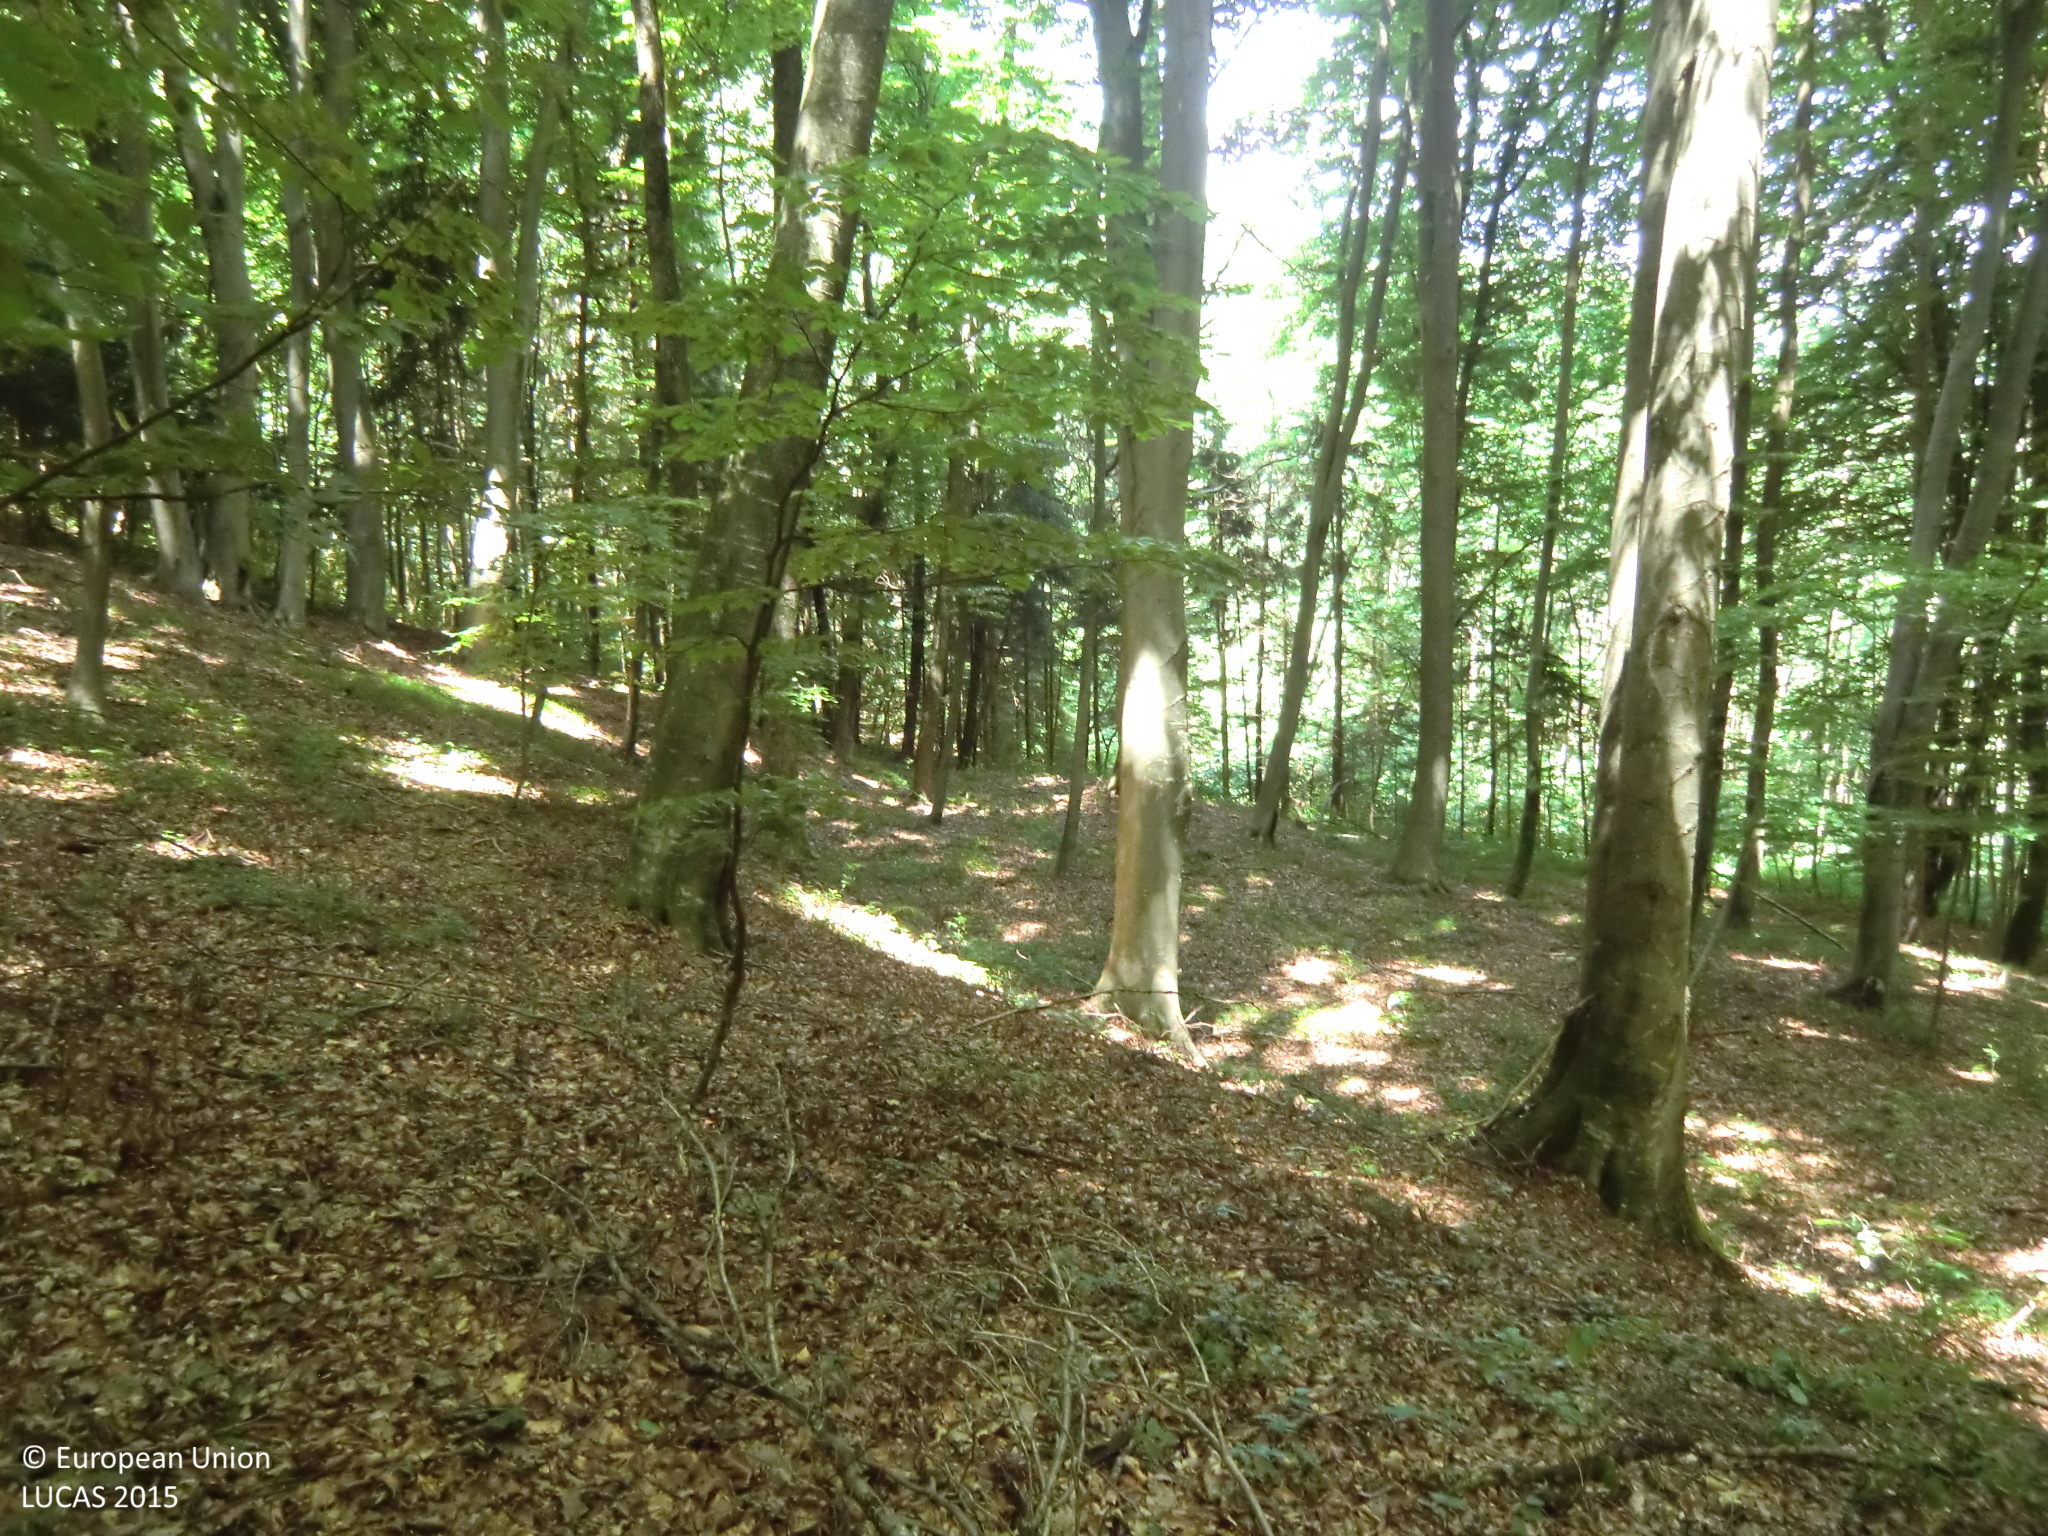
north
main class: Woodland
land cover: Broadleaved woodland
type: beech forest
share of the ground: > 75 %
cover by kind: broadleaved forest trees 90 %, unconsolidated bare surface 10 %
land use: Forestry
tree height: > 5 m
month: July
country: AT
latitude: 46.9753
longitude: 16.0346
